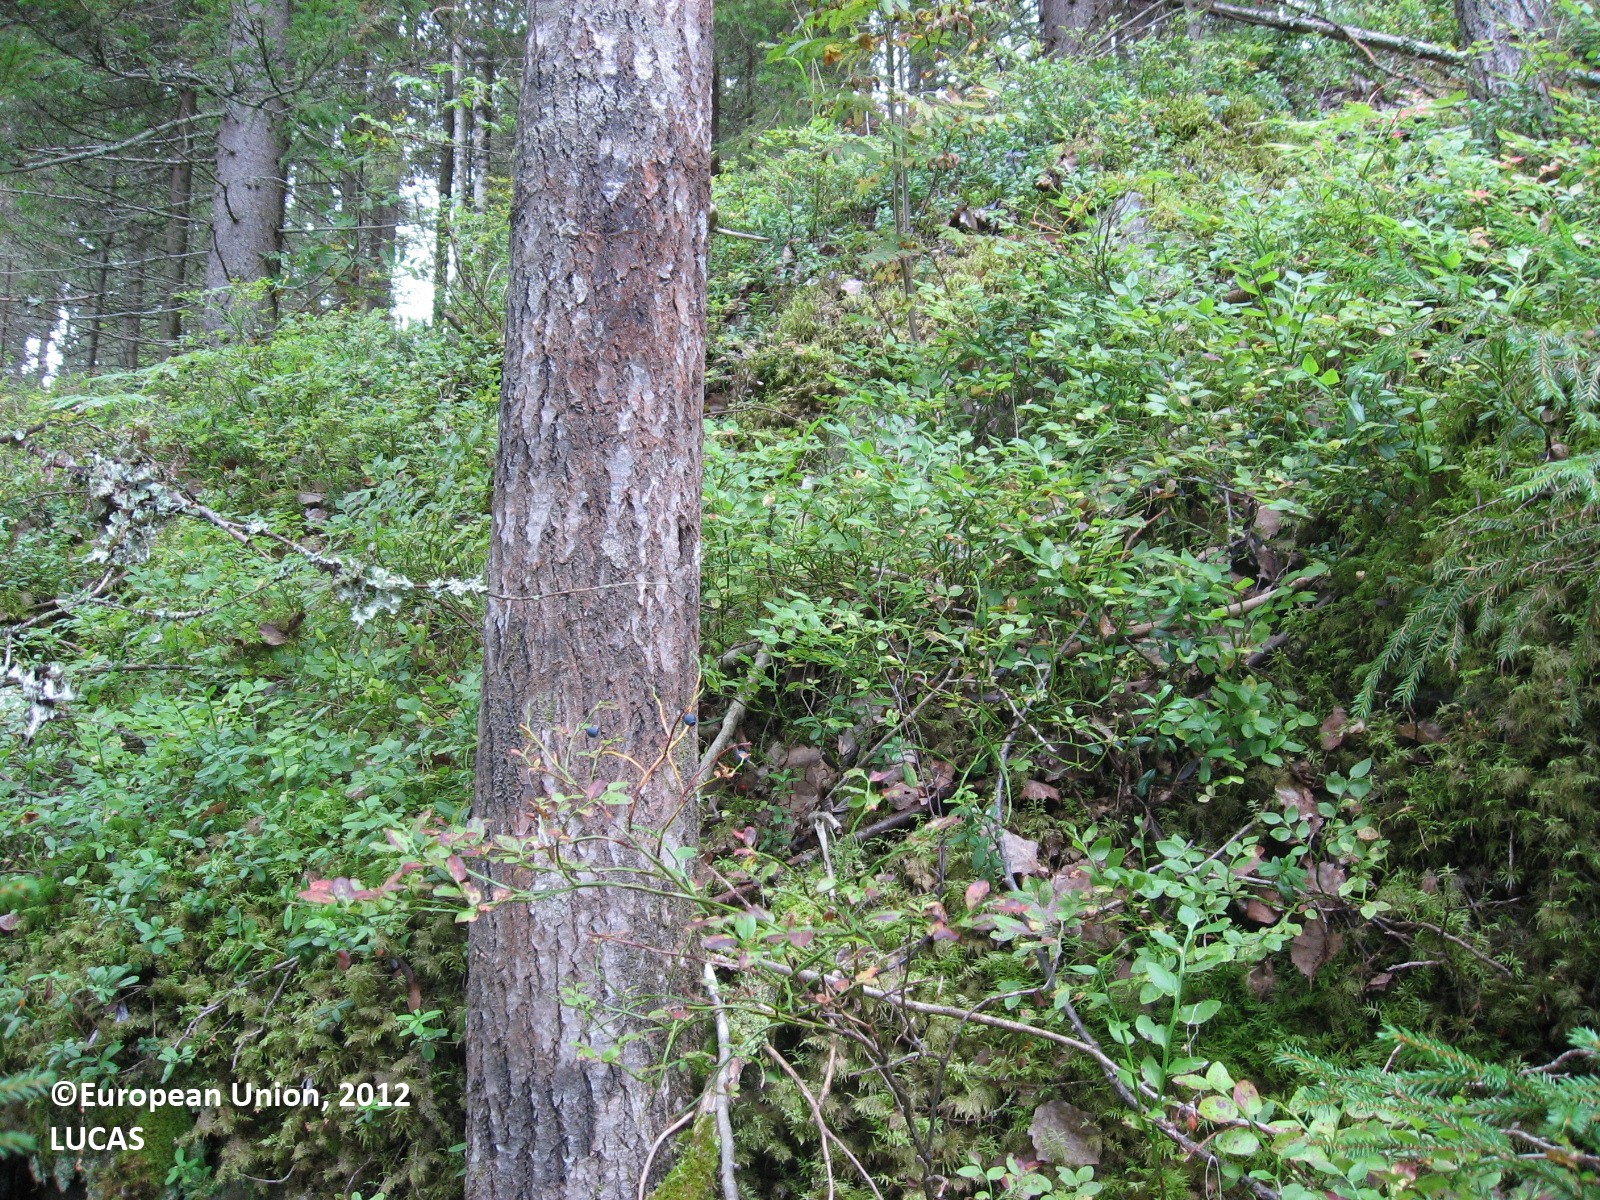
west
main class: Woodland
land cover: Spruce dominated mixed woodland
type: boreal forest
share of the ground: > 75 %
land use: Forestry
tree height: > 5 m
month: August
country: FI
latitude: 60.9108
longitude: 25.5612
